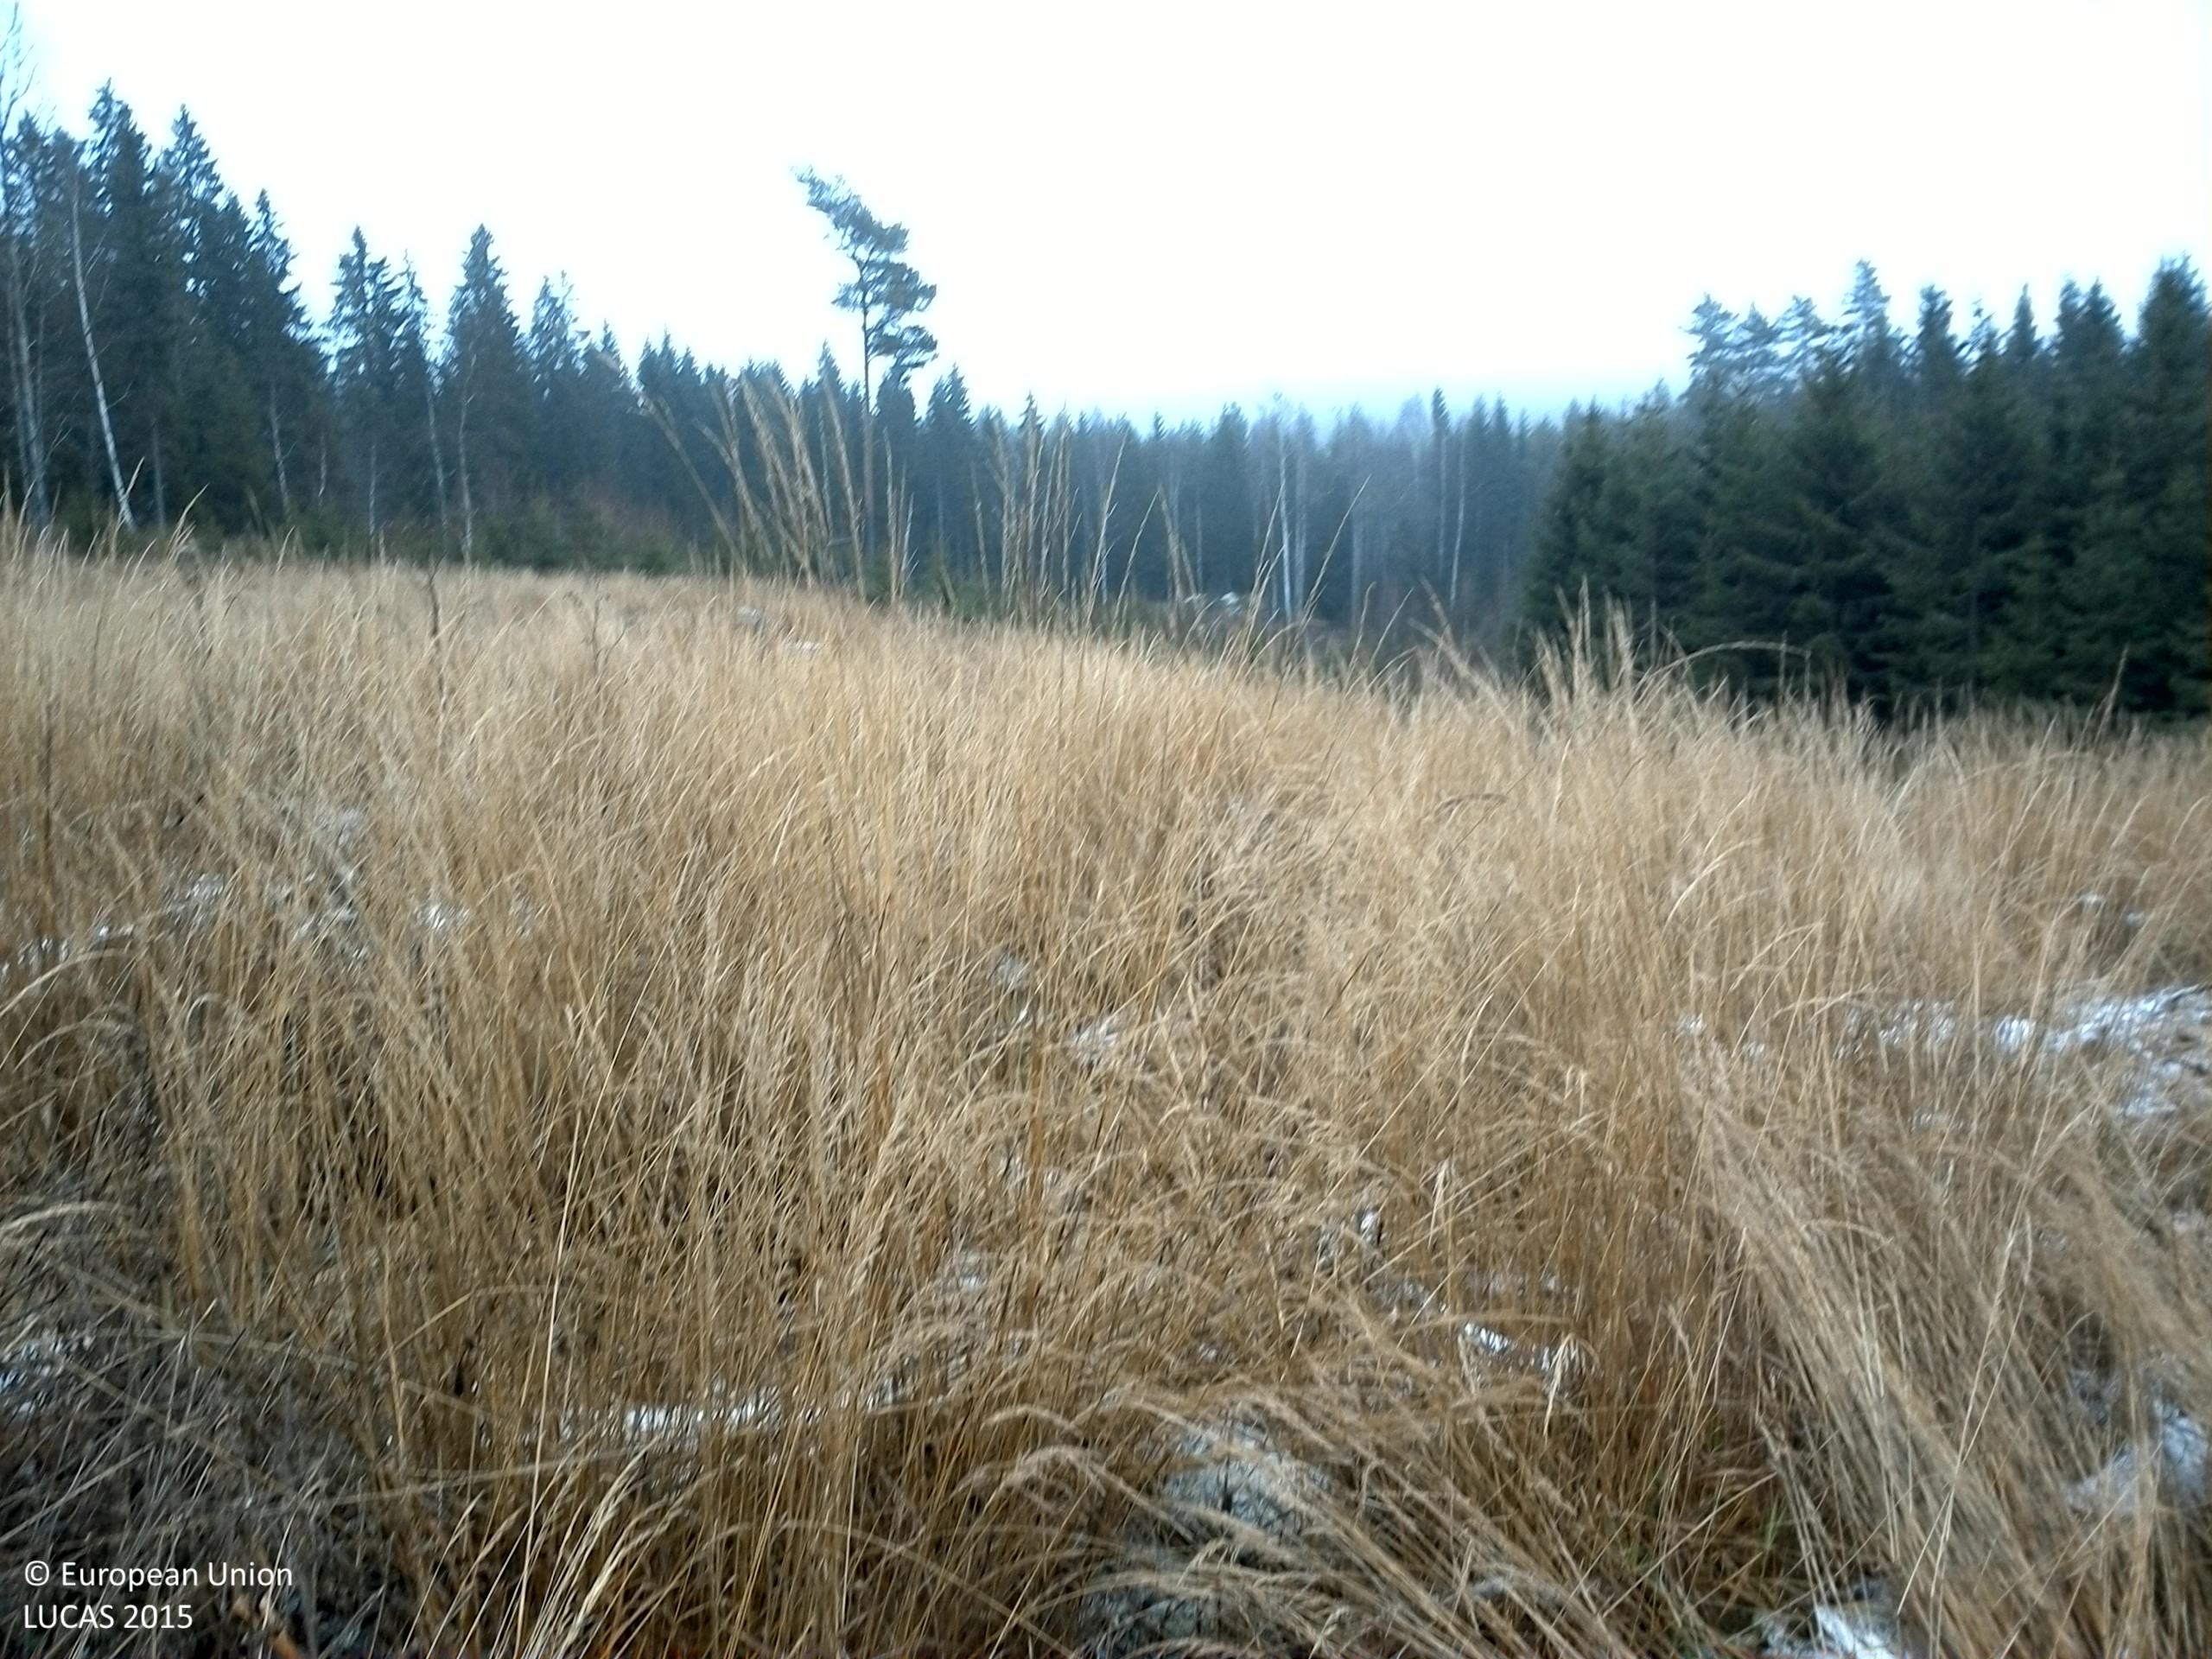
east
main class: Grassland
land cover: Grassland with sparse tree/shrub cover
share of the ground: > 75 %
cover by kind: herbaceous plants 90 %, broadleaved forest trees 5 %, consolidated bare surface 5 %
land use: Forestry
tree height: > 5 m
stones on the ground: < 10 %
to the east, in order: Grassland with sparse tree/shrub cover; Spruce dominated mixed woodland; Broadleaved woodland; Rivers and streams; Spruce dominated mixed woodland; Rivers and streams; Broadleaved woodland; Spruce dominated mixed woodland; Other mixed woodland; Rivers and streams; Spruce dominated mixed woodland; Broadleaved woodland
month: November
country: SE
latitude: 60.2455
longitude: 16.5469
